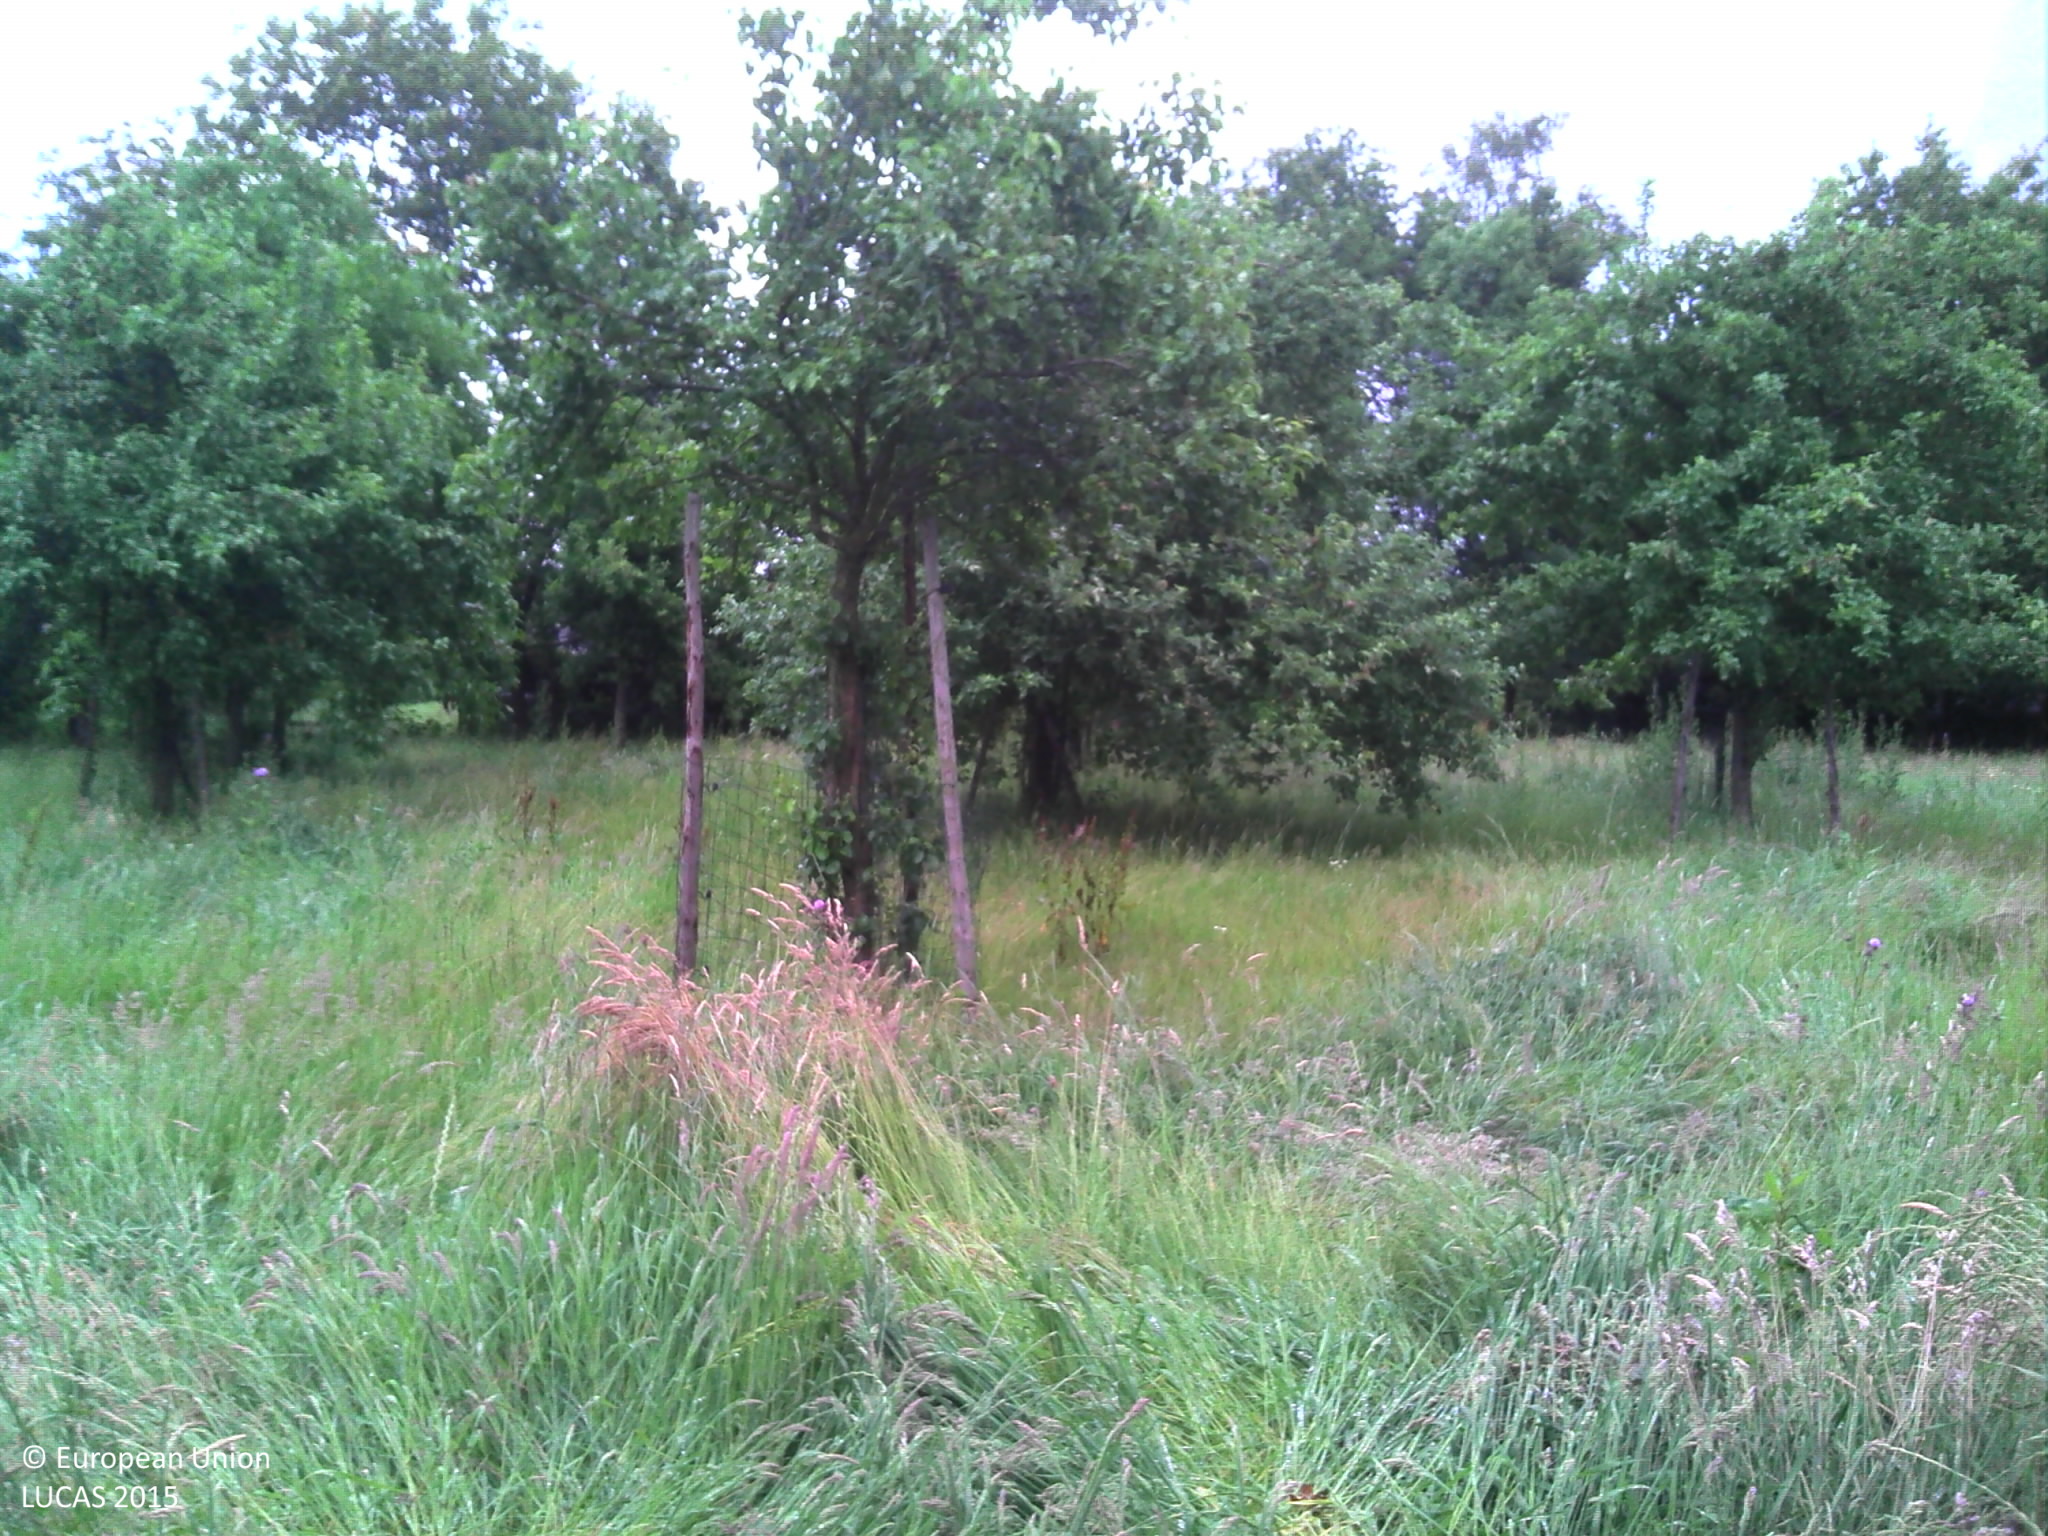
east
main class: Cropland
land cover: Apple fruit
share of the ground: 25 - 50 %
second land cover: Grassland without tree/shrub cover
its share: > 75 %
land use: Agriculture (excluding fallow land and kitchen gardens)
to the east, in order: Apple fruit; Grassland without tree/shrub cover; Fences; Lines of trees; Fences; Lines of trees; Ditches and canals; Artificial constructions in urban areas; Maize
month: June
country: BE
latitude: 51.1056
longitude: 3.9526
